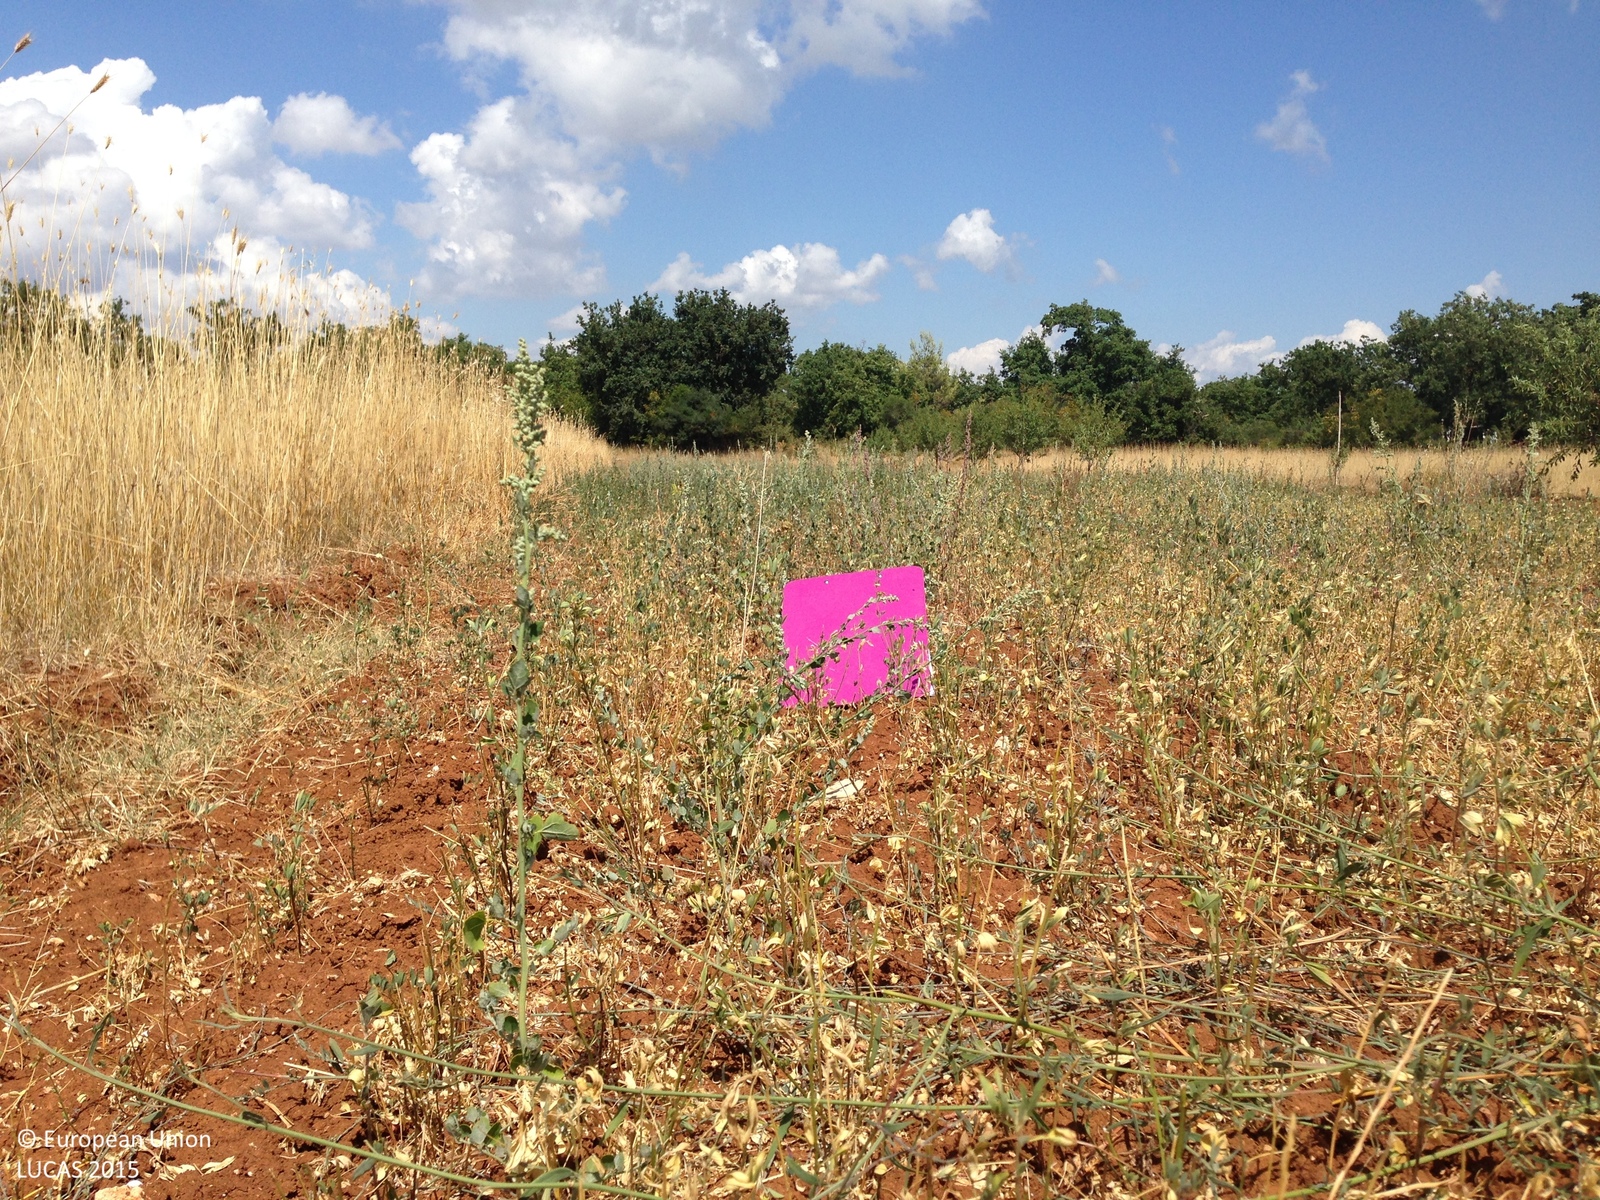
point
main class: Grassland
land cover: Spontaneously vegetated surfaces
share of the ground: > 75 %
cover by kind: herbaceous plants 60 %, unconsolidated bare surface 40 %
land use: Fallow land
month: July
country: HR
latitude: 43.9537
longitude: 15.4620
